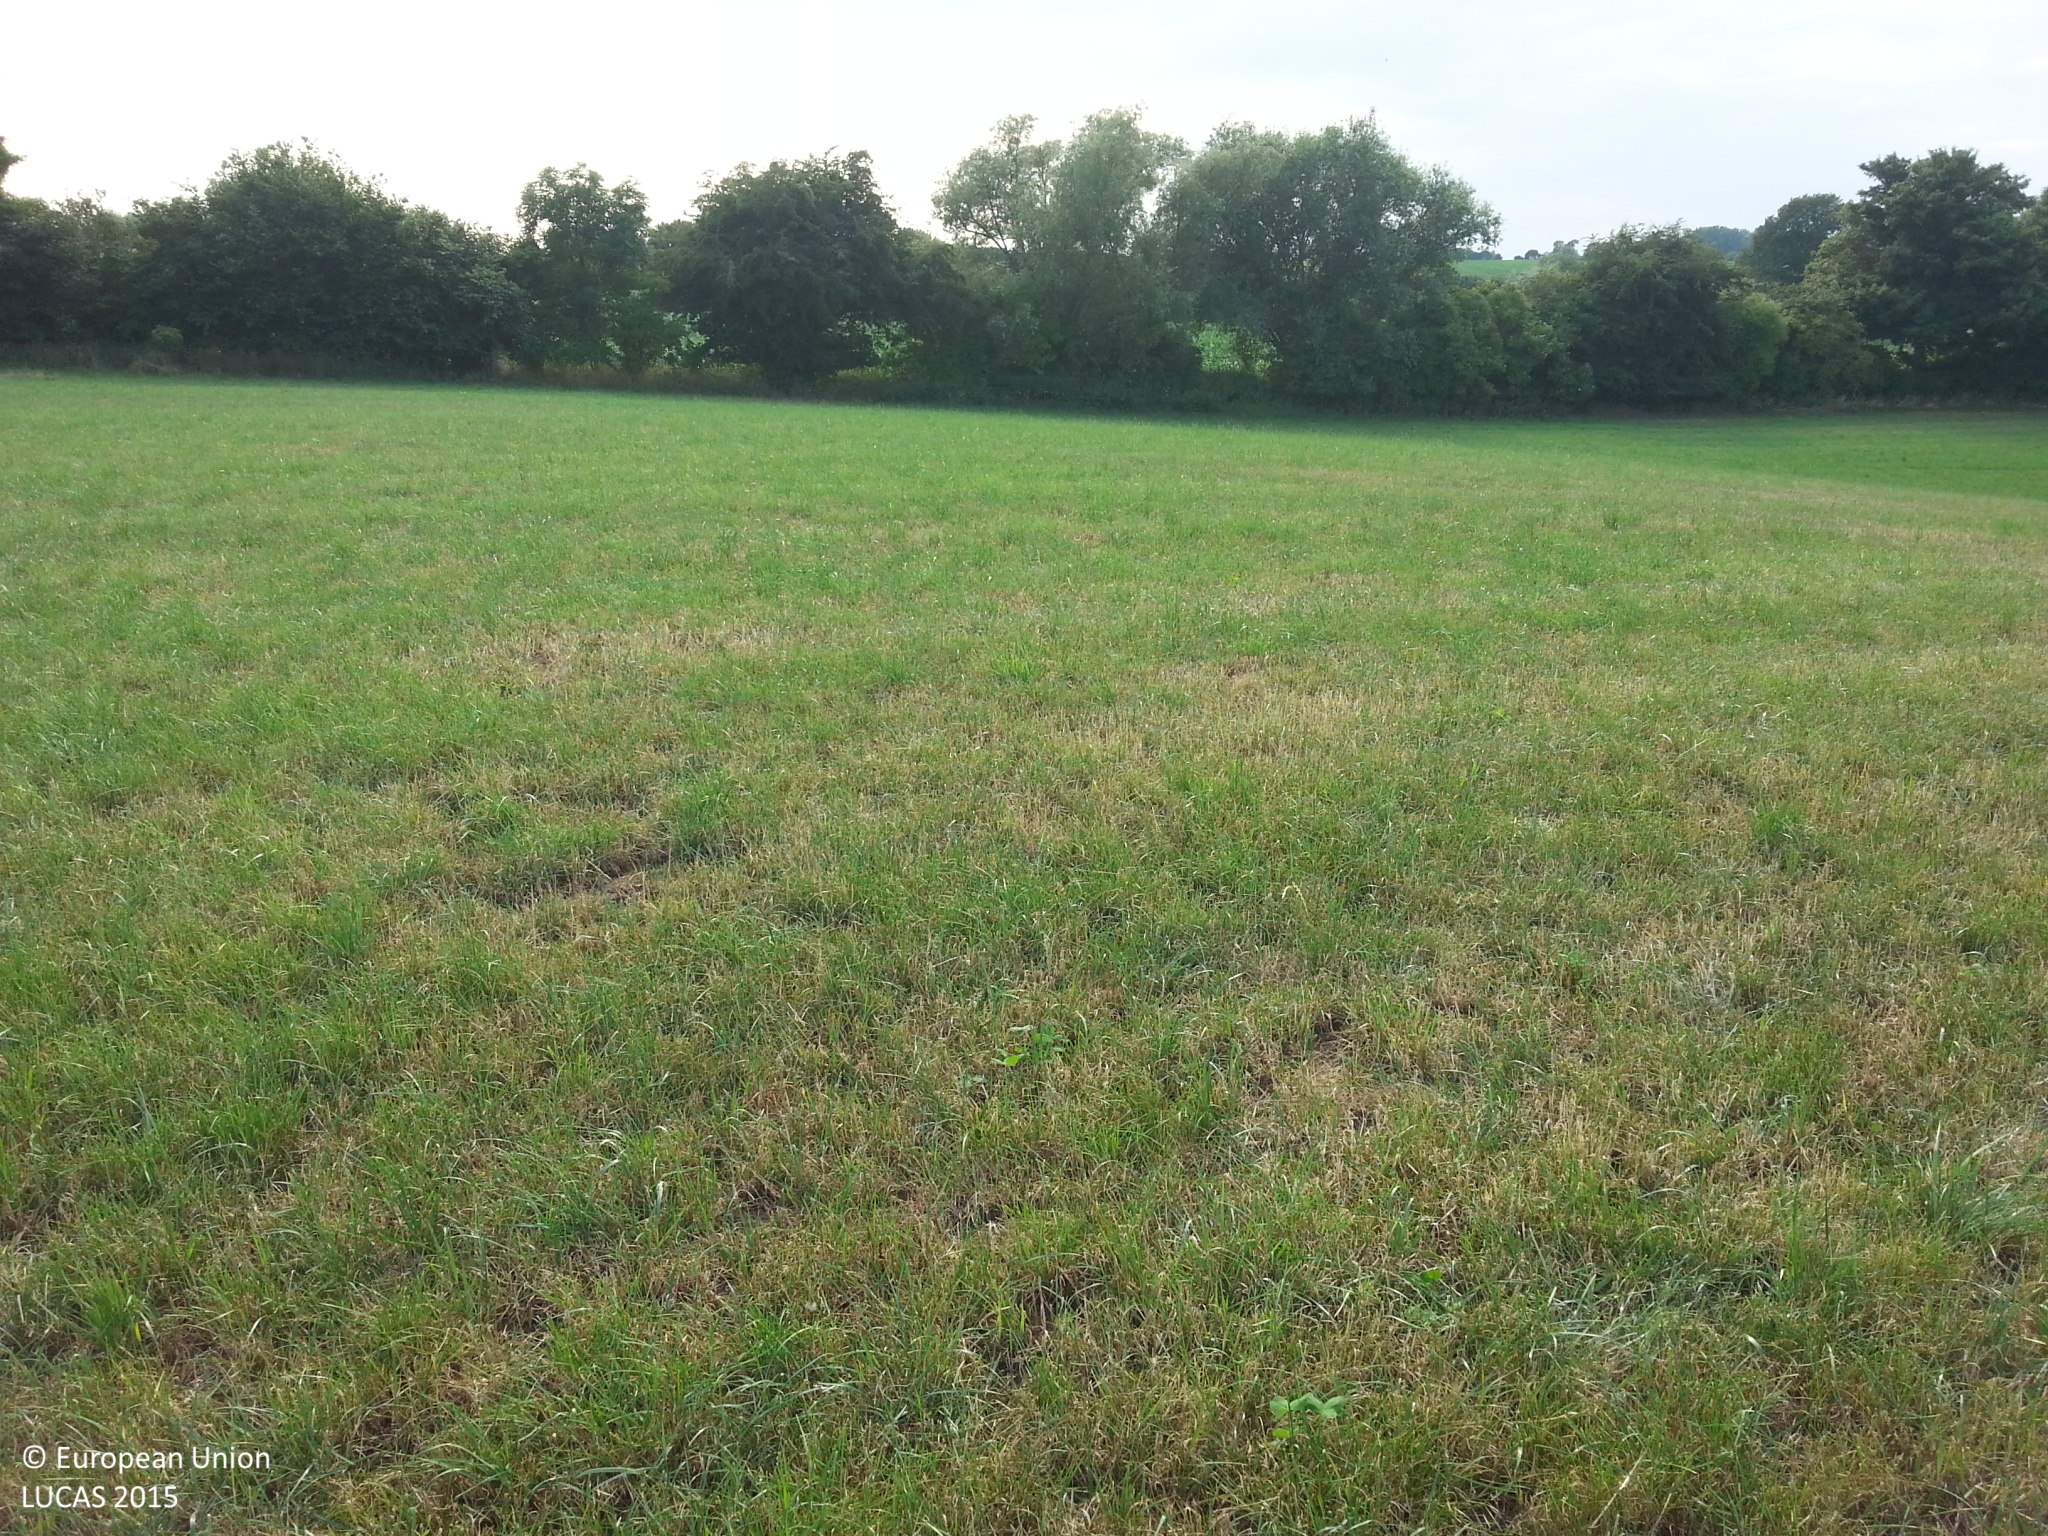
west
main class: Grassland
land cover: Grassland without tree/shrub cover
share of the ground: > 75 %
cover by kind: herbaceous plants 100 %
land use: Agriculture (excluding fallow land and kitchen gardens)
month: July
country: DE
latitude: 54.0076
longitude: 11.1438
